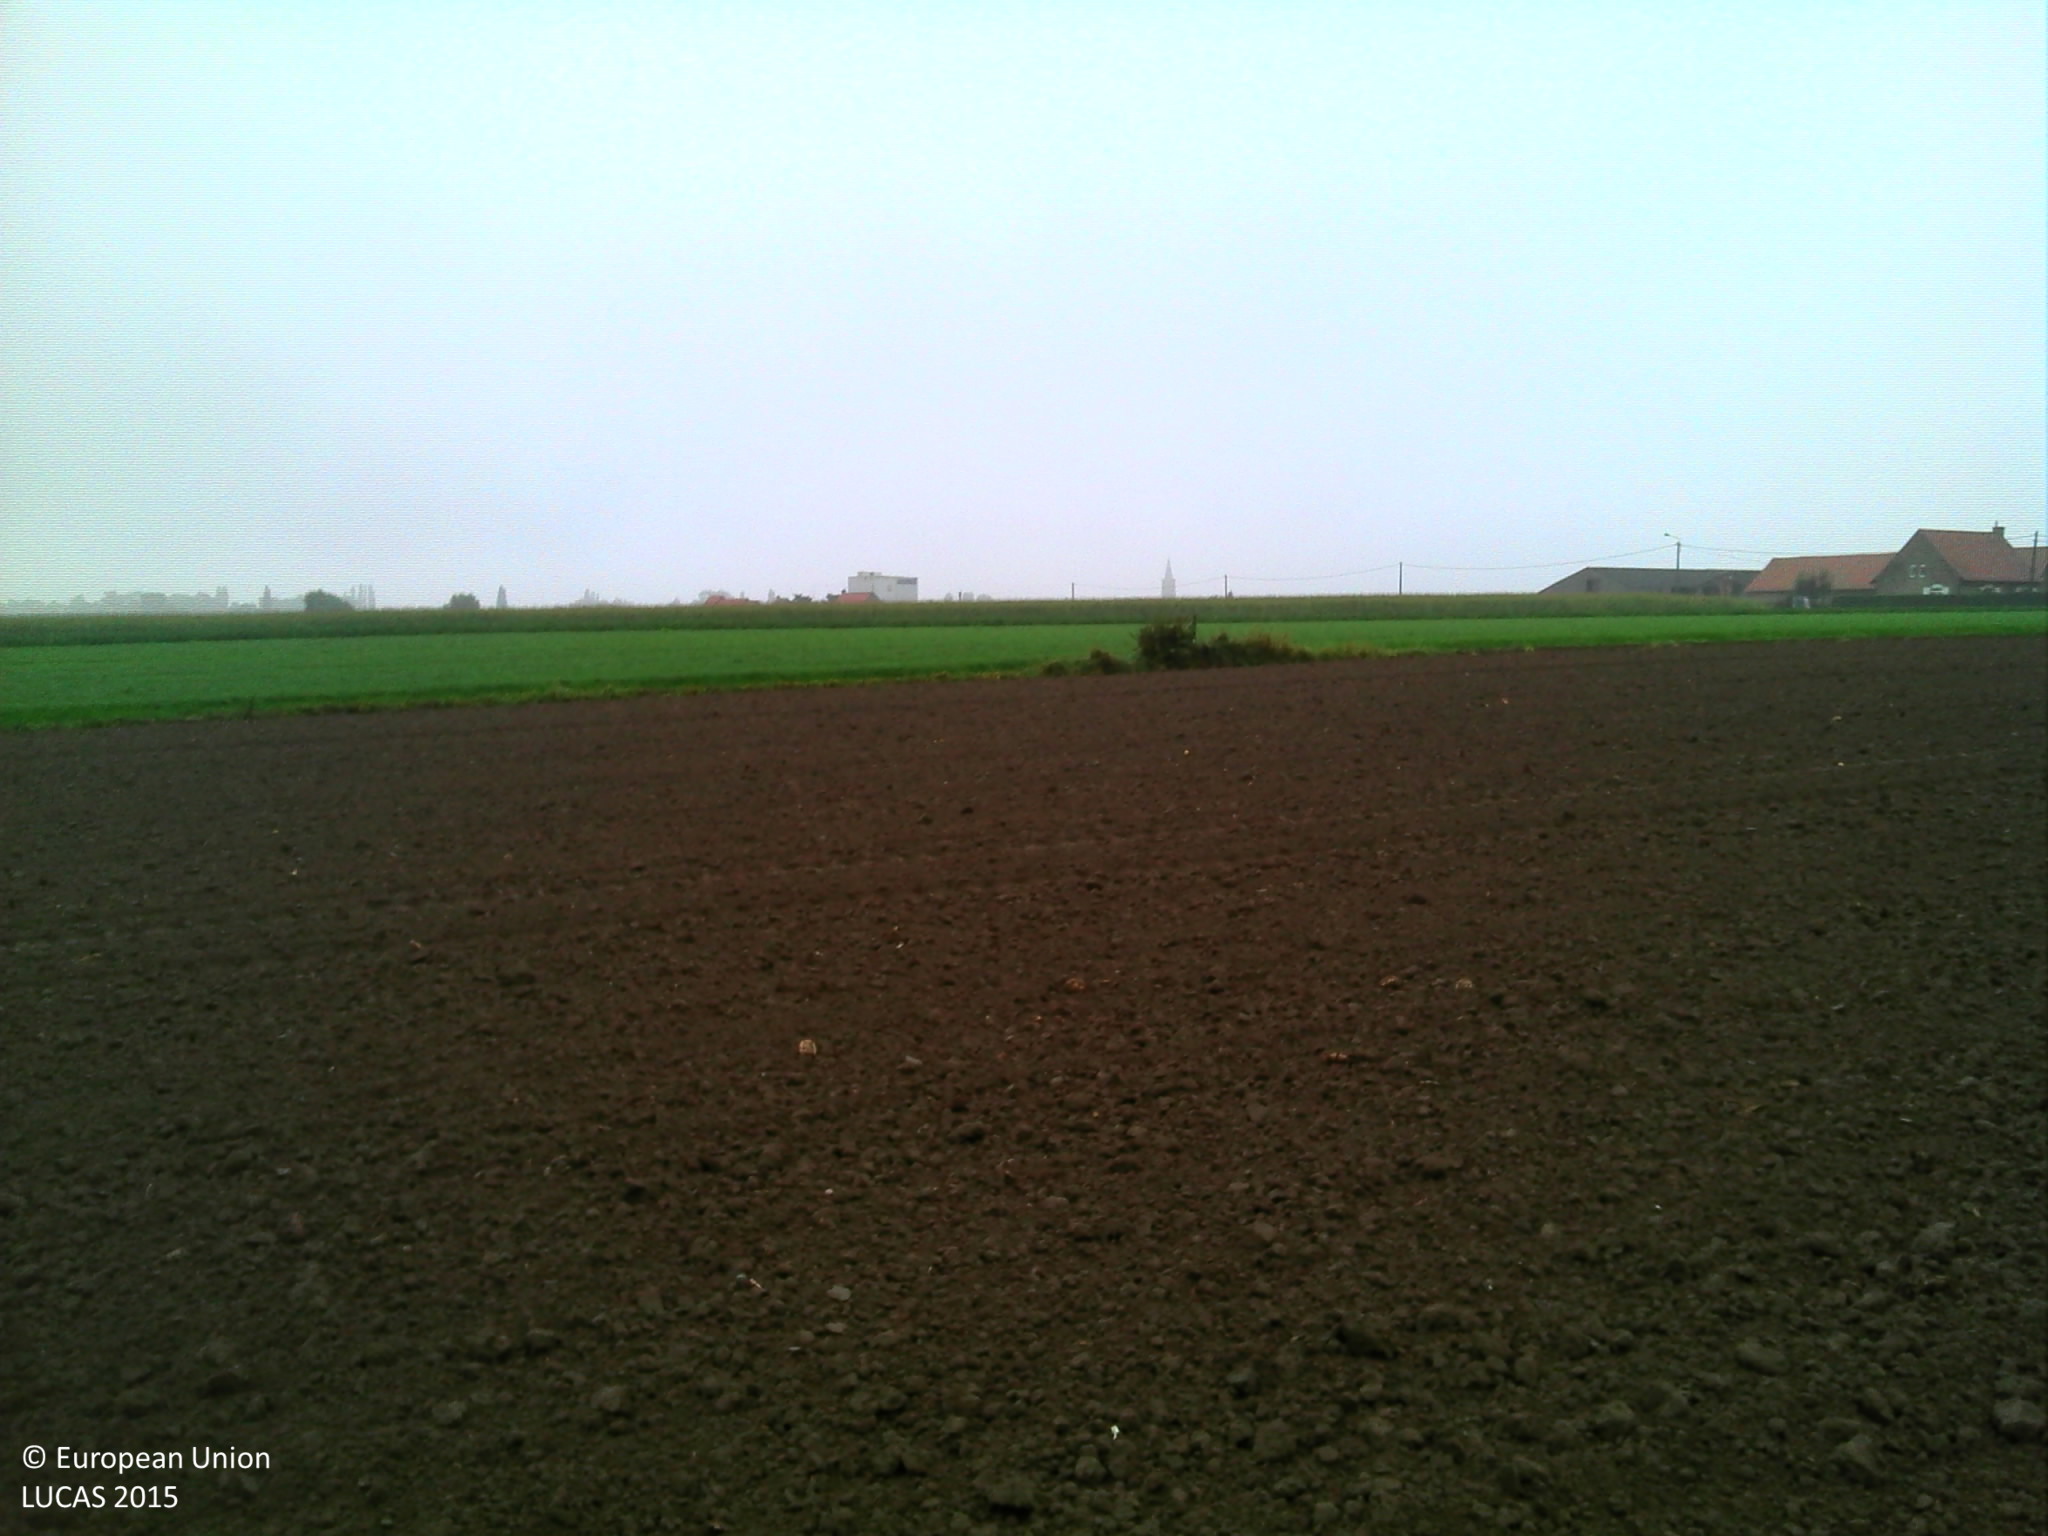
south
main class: Cropland
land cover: Barley
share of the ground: < 10 %
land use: Agriculture (excluding fallow land and kitchen gardens)
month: October
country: BE
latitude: 51.0101
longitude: 2.9058
